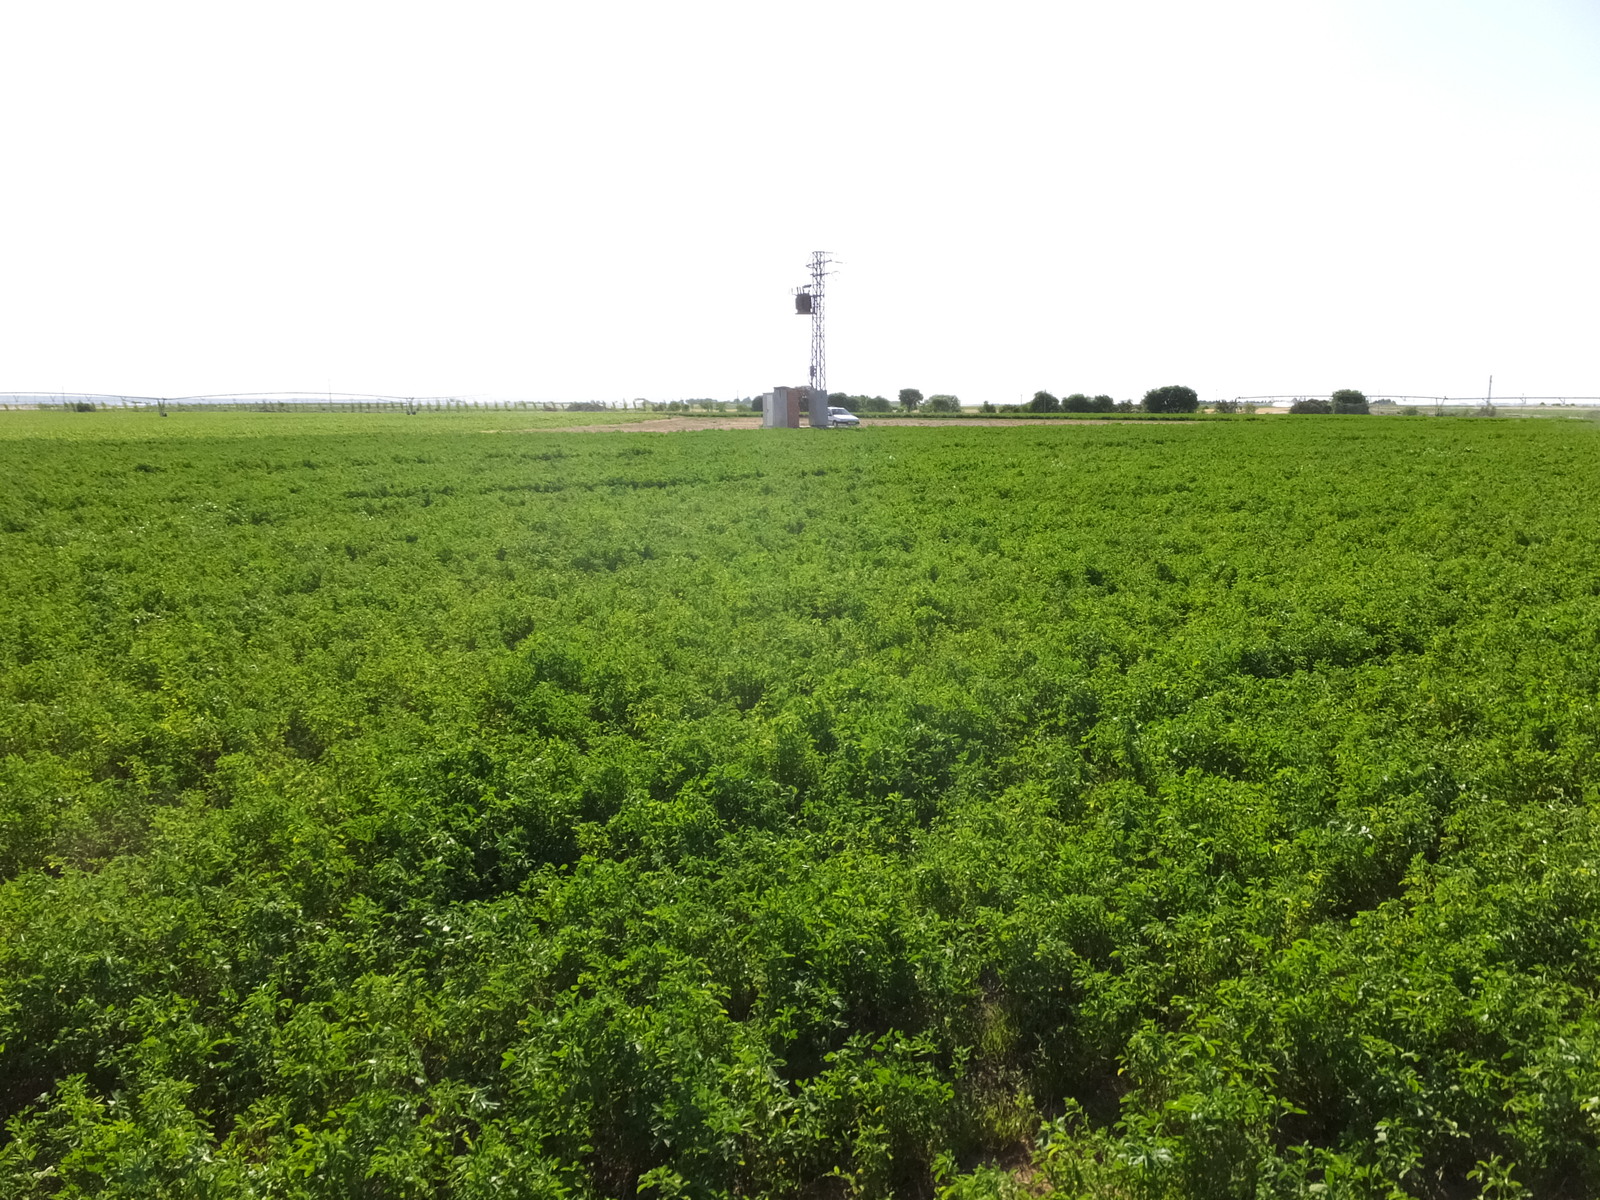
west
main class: Cropland
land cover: Lucerne
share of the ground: > 75 %
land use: Agriculture (excluding fallow land and kitchen gardens)
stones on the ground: < 10 %
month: May
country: ES
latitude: 41.6555
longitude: 0.4399
